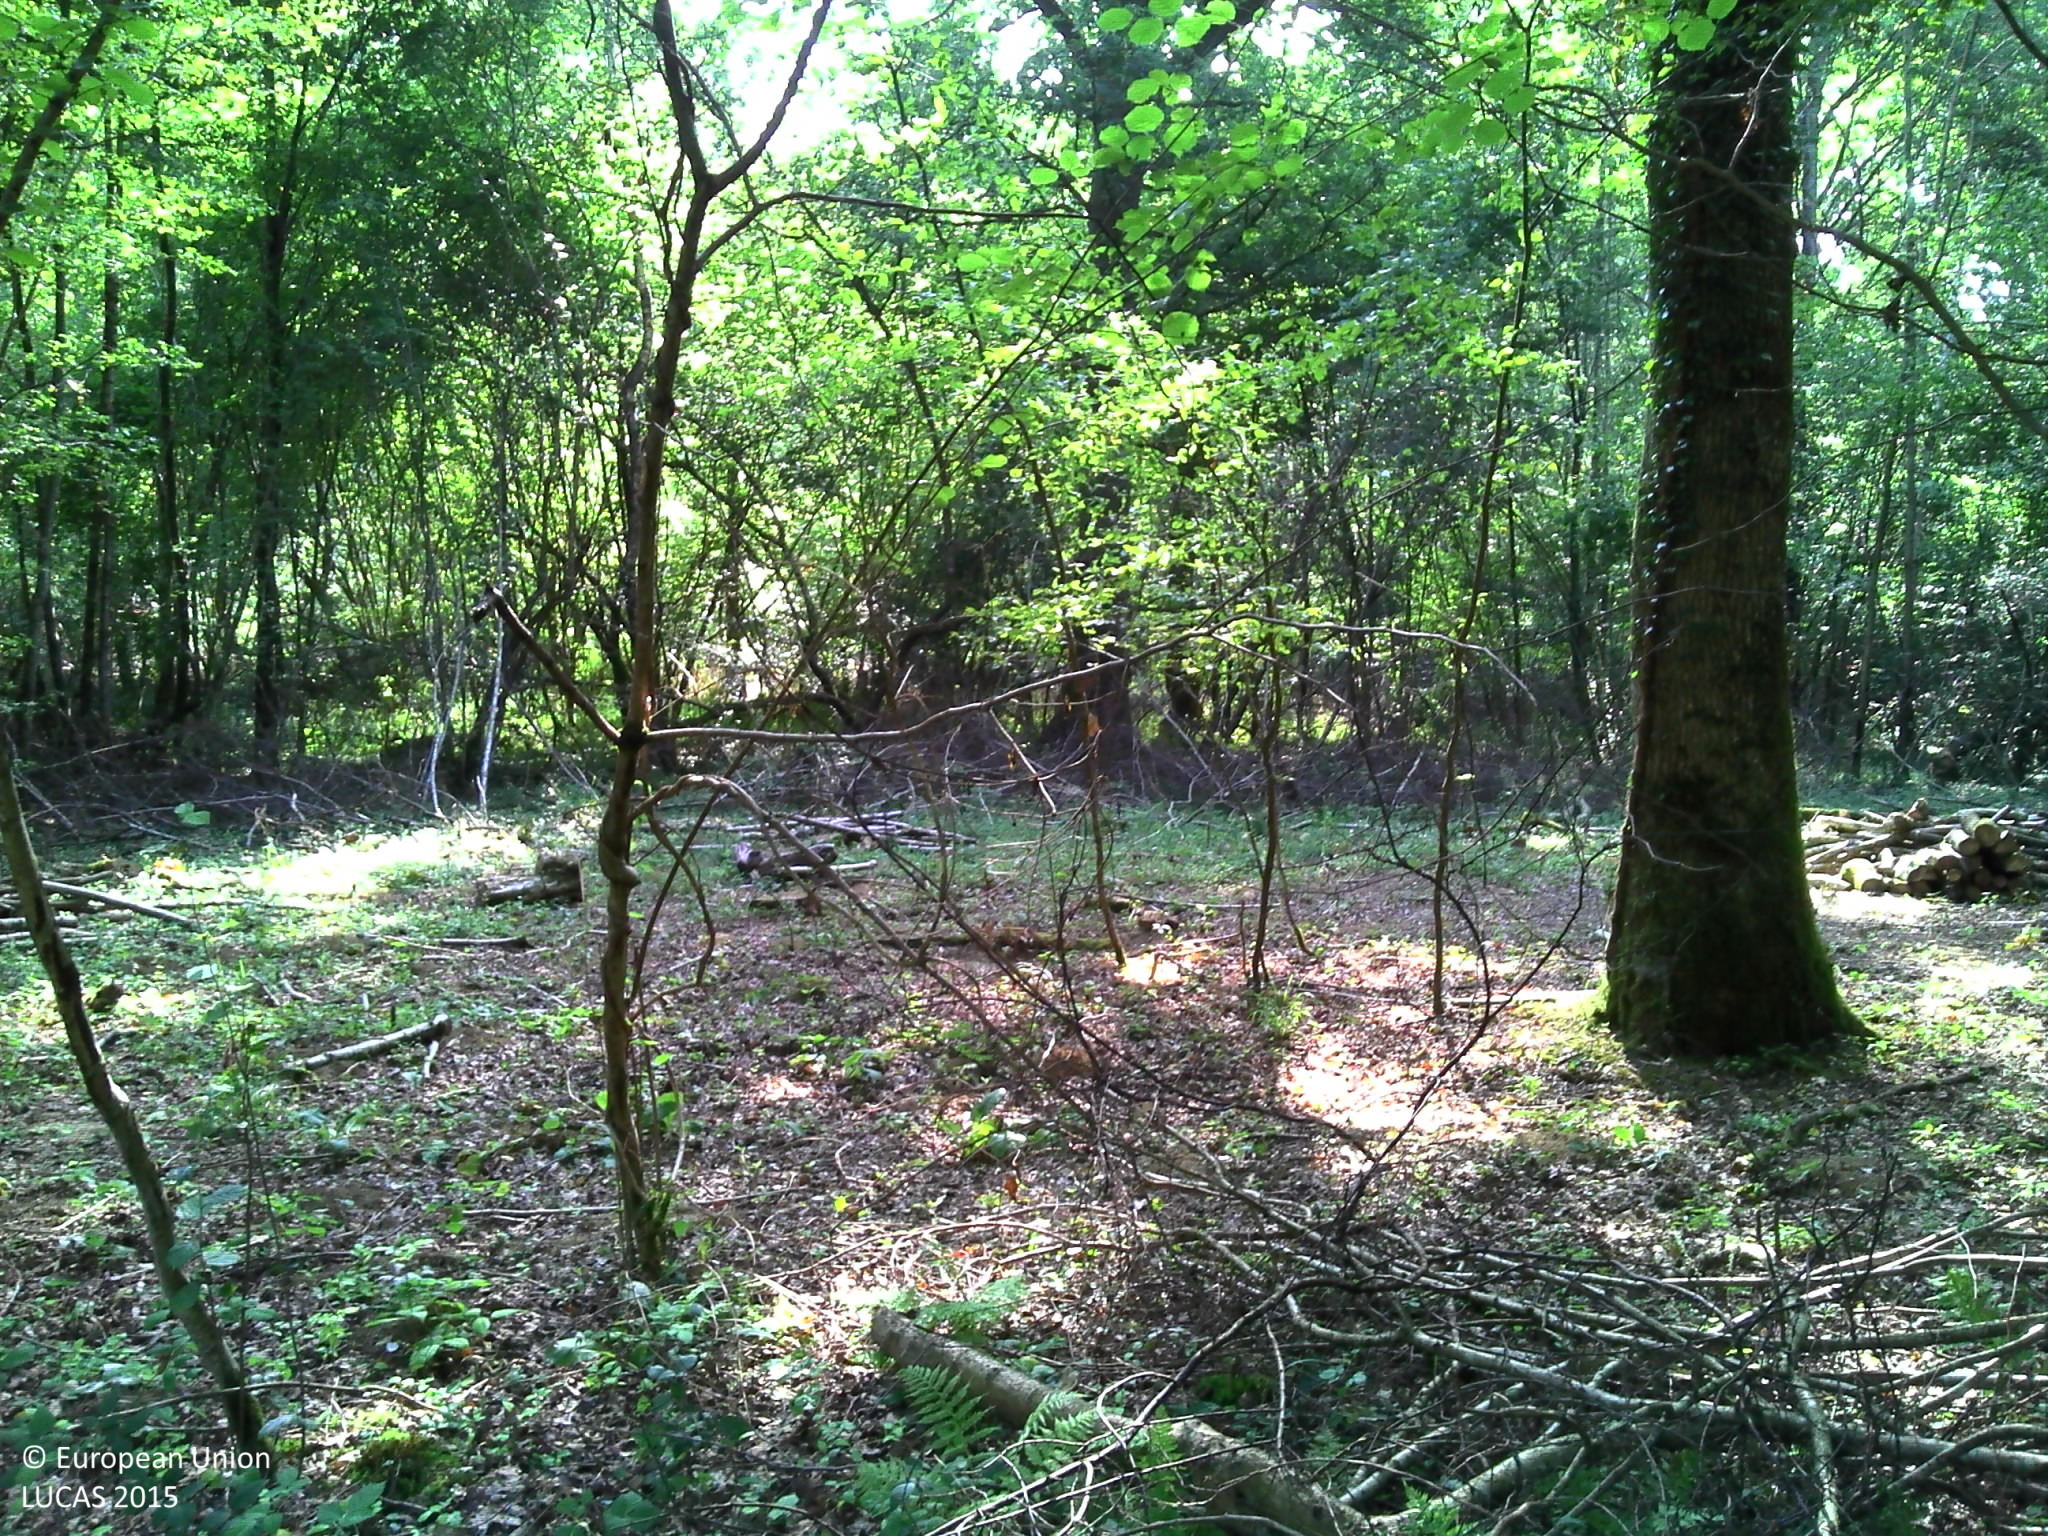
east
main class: Woodland
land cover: Broadleaved woodland
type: mesophytic deciduous forest
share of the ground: > 75 %
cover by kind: herbaceous plants 40 %, broadleaved forest trees 35 %, unconsolidated bare surface 15 %, lichens and mosses 5 %
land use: Forestry
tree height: > 5 m
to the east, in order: Broadleaved woodland
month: August
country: FR
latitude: 49.0203
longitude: 3.7450
